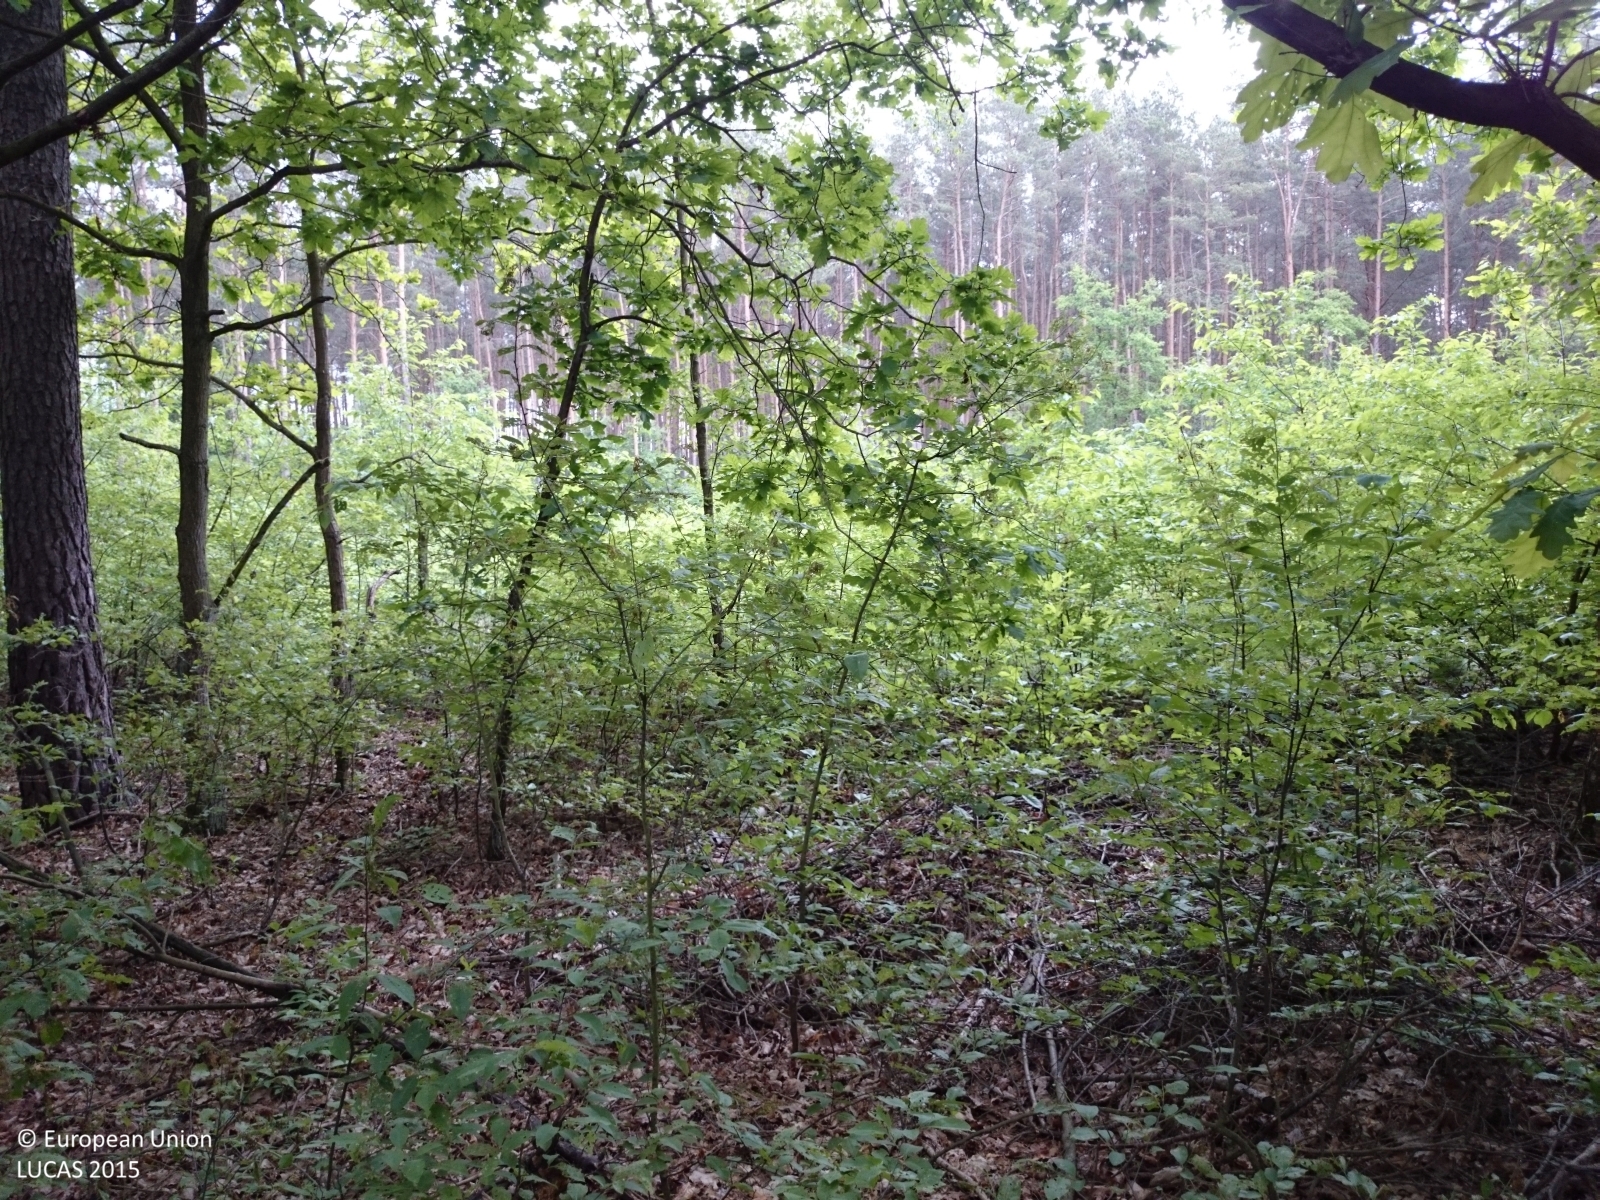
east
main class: Woodland
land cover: Pine dominated mixed woodland
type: hemiboreal forest and nemoral coniferous forest and mixed broadleaved-coniferous forest
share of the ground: > 75 %
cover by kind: coniferous forest trees 75 %, broadleaved forest trees 25 %
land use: Forestry
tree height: > 5 m
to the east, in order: Pine dominated mixed woodland; Fences; Grassland with sparse tree/shrub cover; Fences; Tracks; Pine dominated coniferous woodland
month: May
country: PL
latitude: 52.6029
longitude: 15.6595
